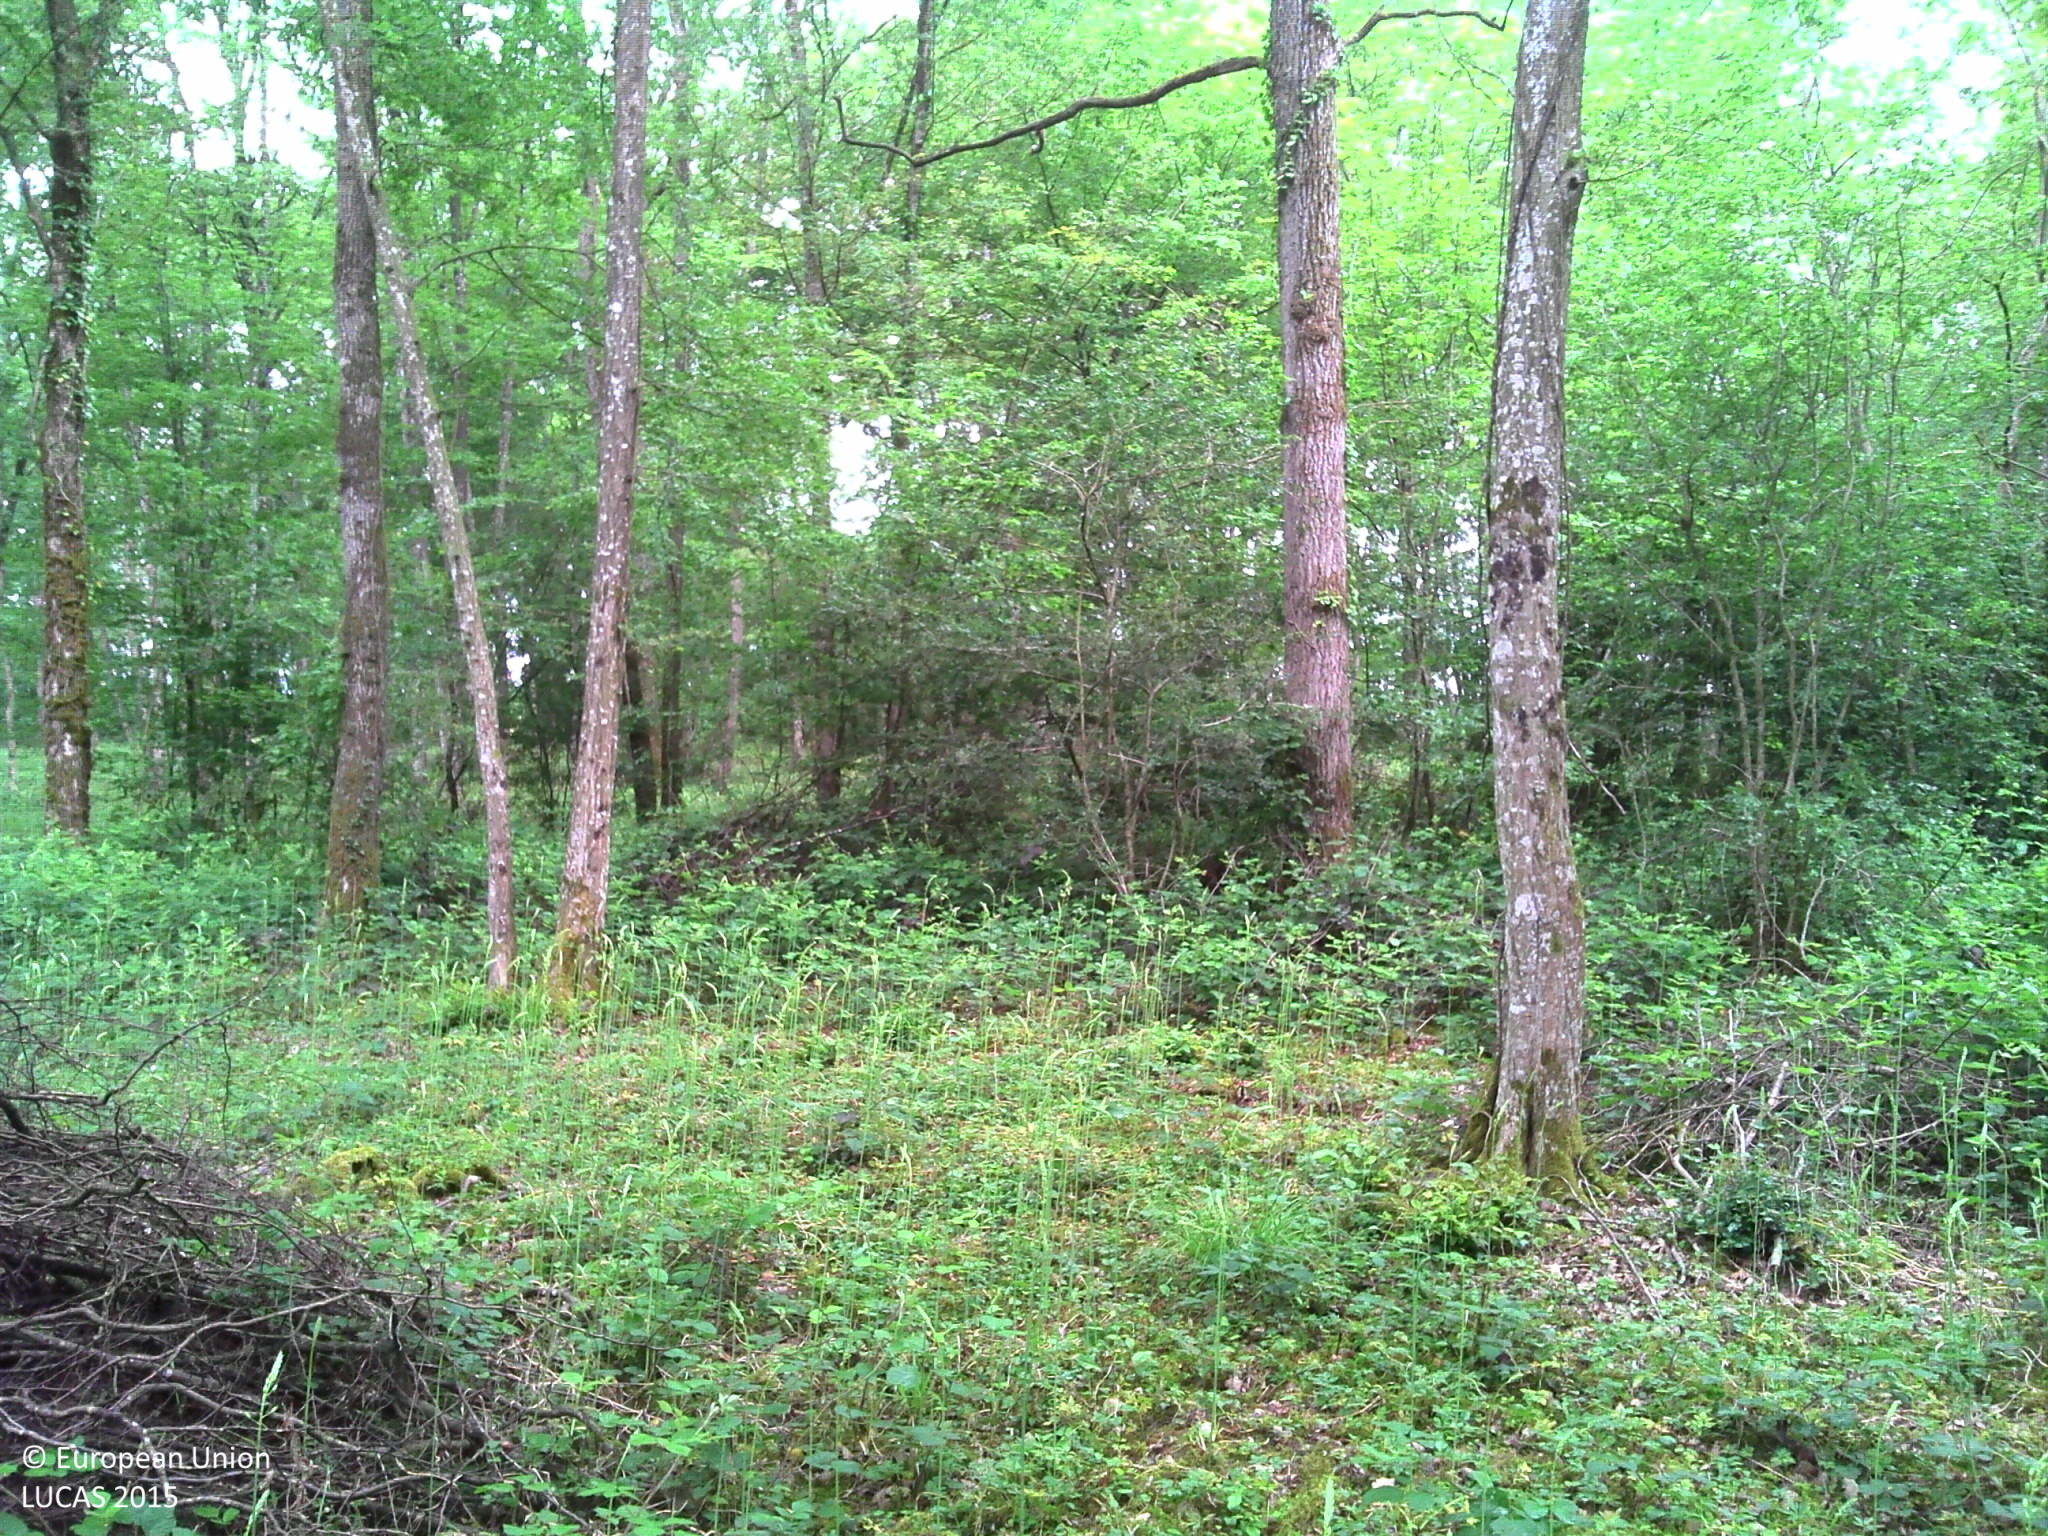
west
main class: Woodland
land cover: Broadleaved woodland
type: mesophytic deciduous forest
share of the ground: > 75 %
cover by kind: broadleaved forest trees 90 %, herbaceous plants 5 %, lichens and mosses 5 %
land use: Forestry
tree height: > 5 m
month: June
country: FR
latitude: 47.3927
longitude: 5.0853
